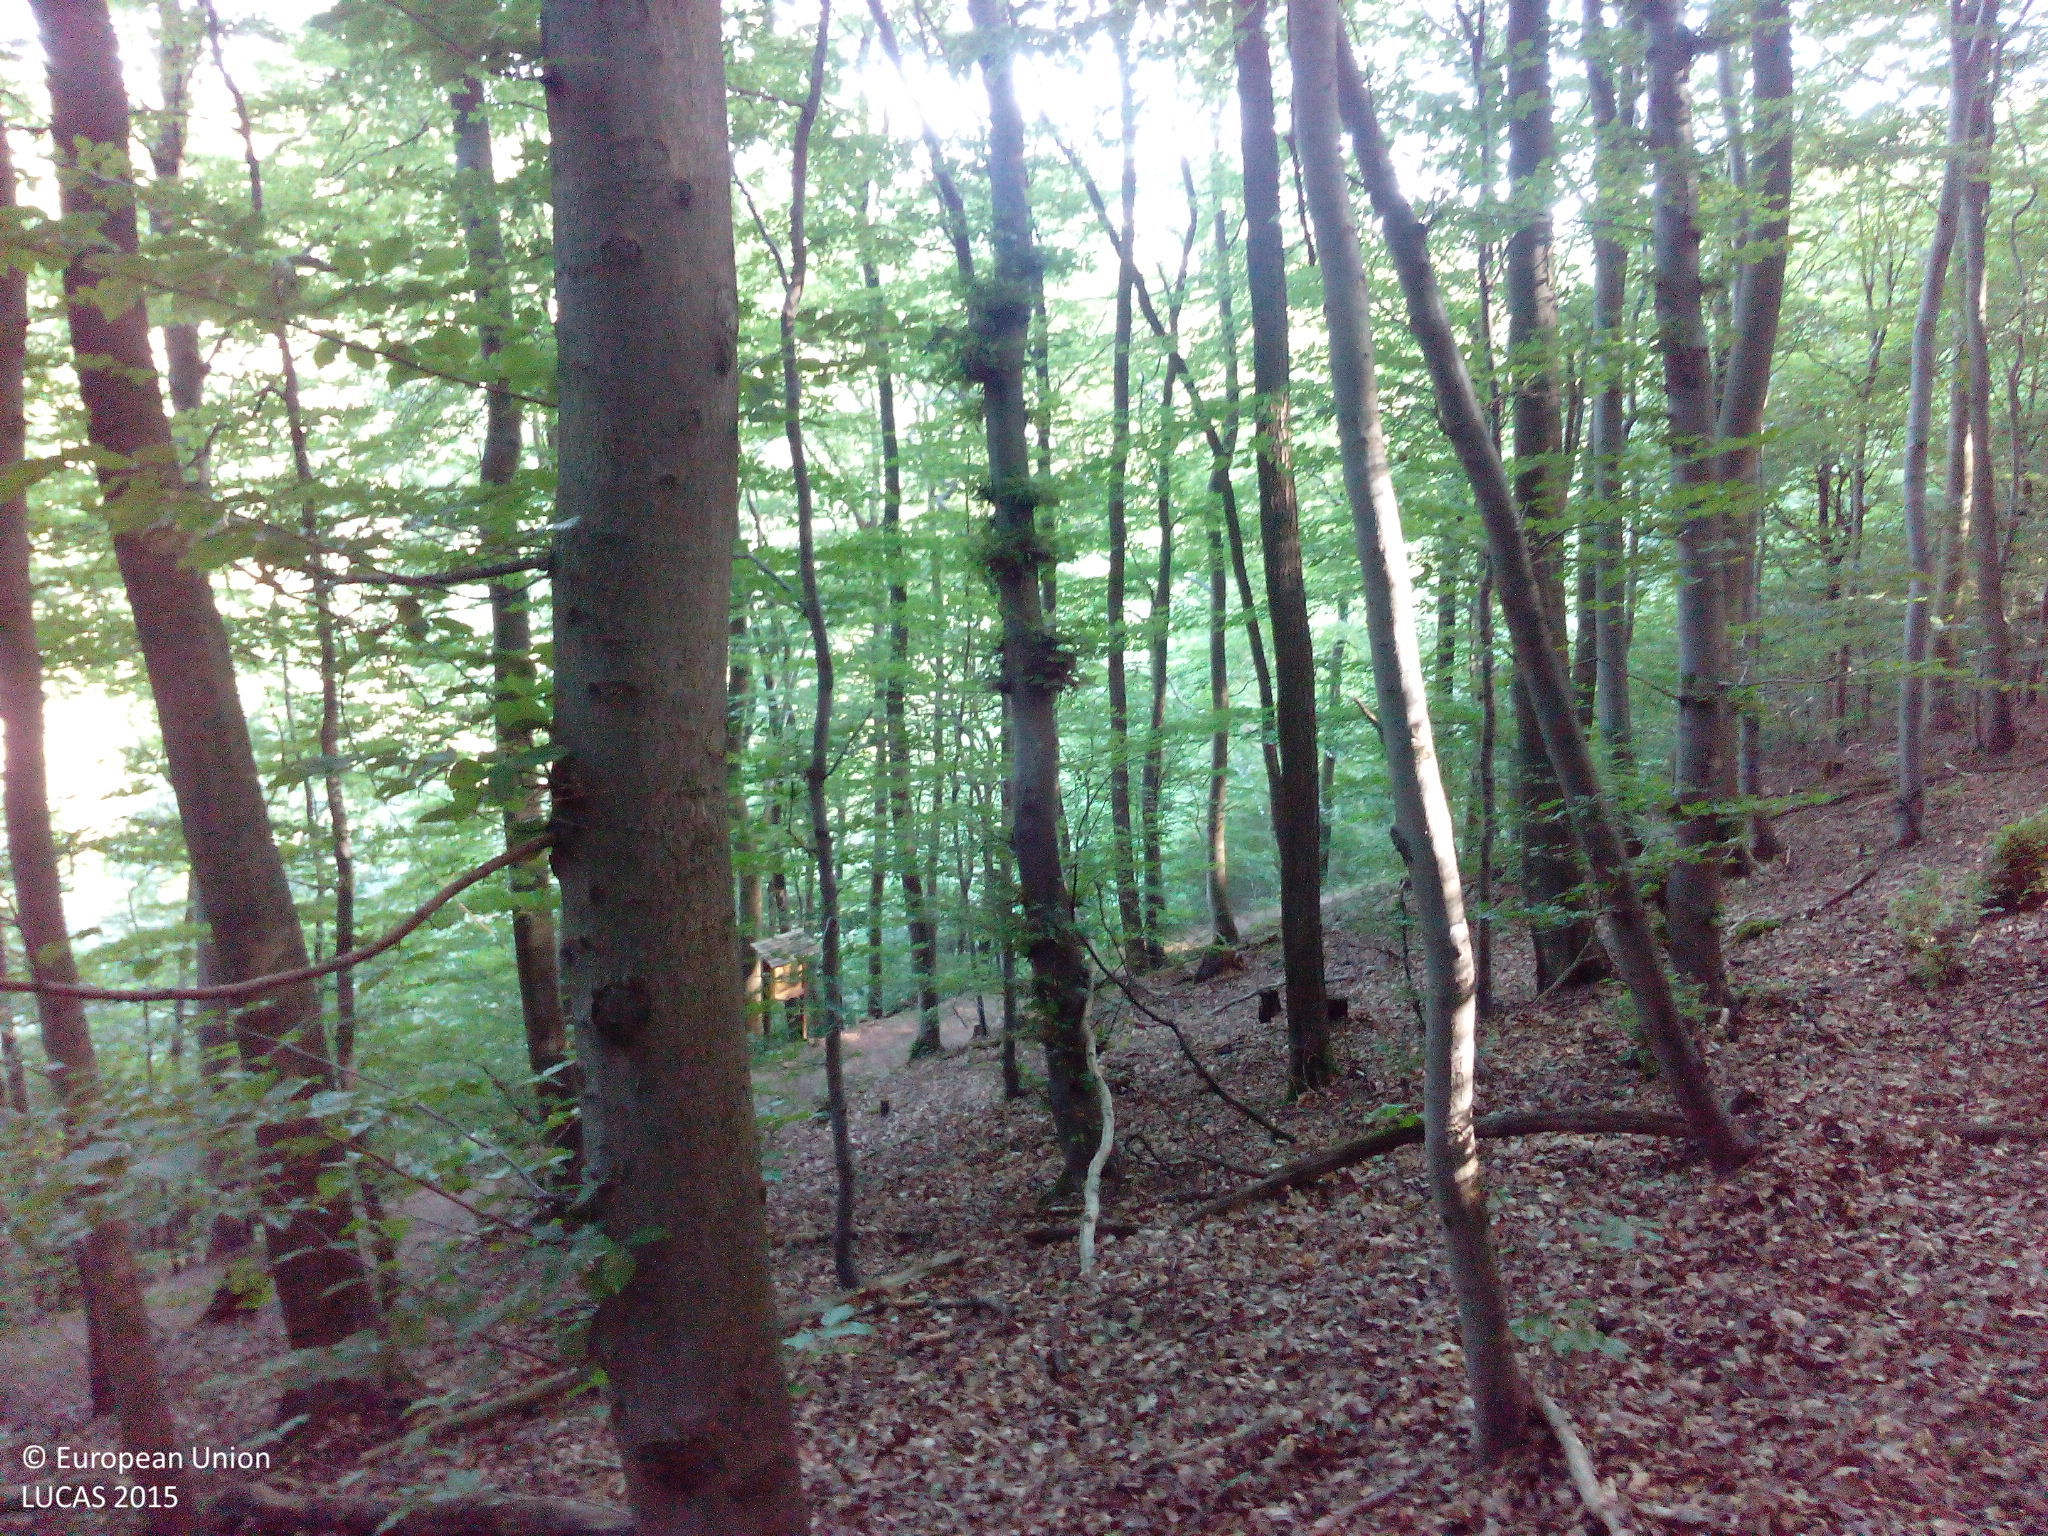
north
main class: Woodland
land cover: Broadleaved woodland
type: beech forest
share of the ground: > 75 %
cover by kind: broadleaved forest trees 90 %, unconsolidated bare surface 10 %
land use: Forestry
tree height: > 5 m
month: July
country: DE
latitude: 49.8153
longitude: 7.5127
